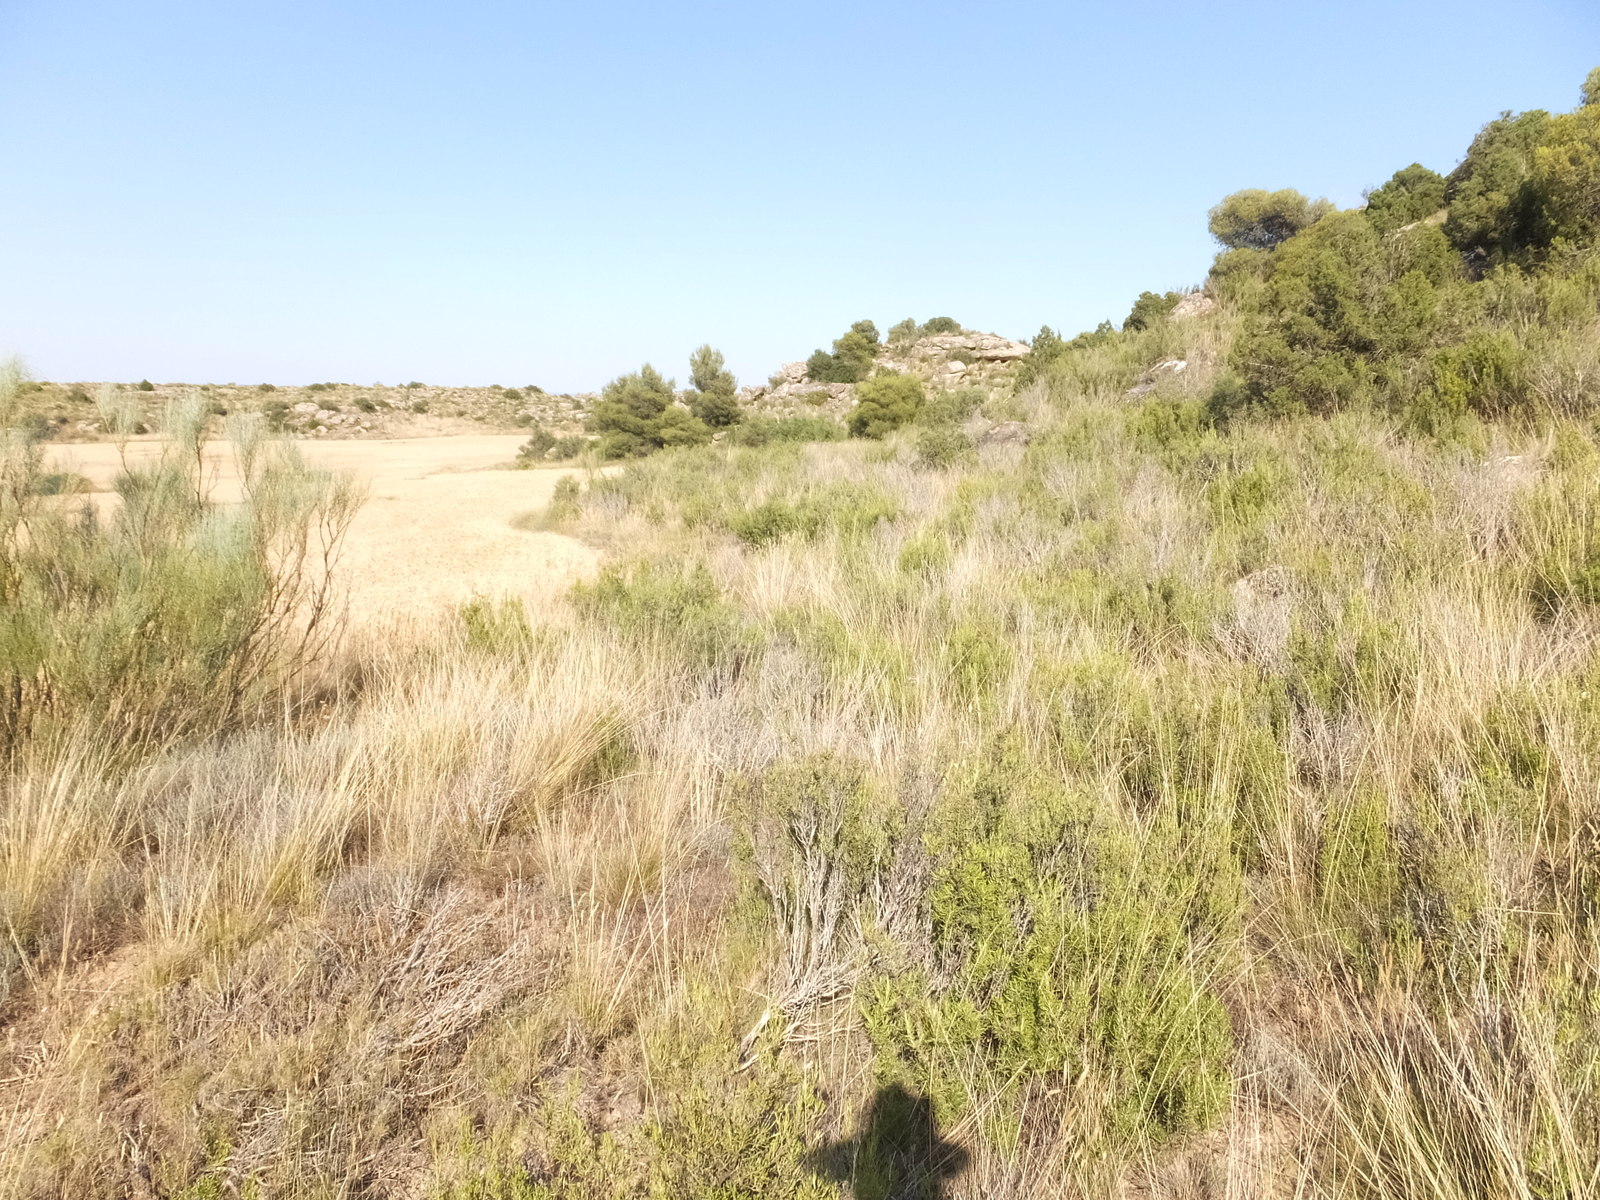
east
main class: Shrubland
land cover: Shrubland without tree cover
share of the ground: > 75 %
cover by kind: shrubs 50 %, herbaceous plants 50 %
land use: Semi-natural and natural areas not in use
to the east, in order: Shrubland without tree cover; Shrubland with sparse tree cover; Common wheat; Shruby margins; Tracks; Common wheat; Shruby margins; Common wheat
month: June
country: ES
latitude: 41.2087
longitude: -0.2101
